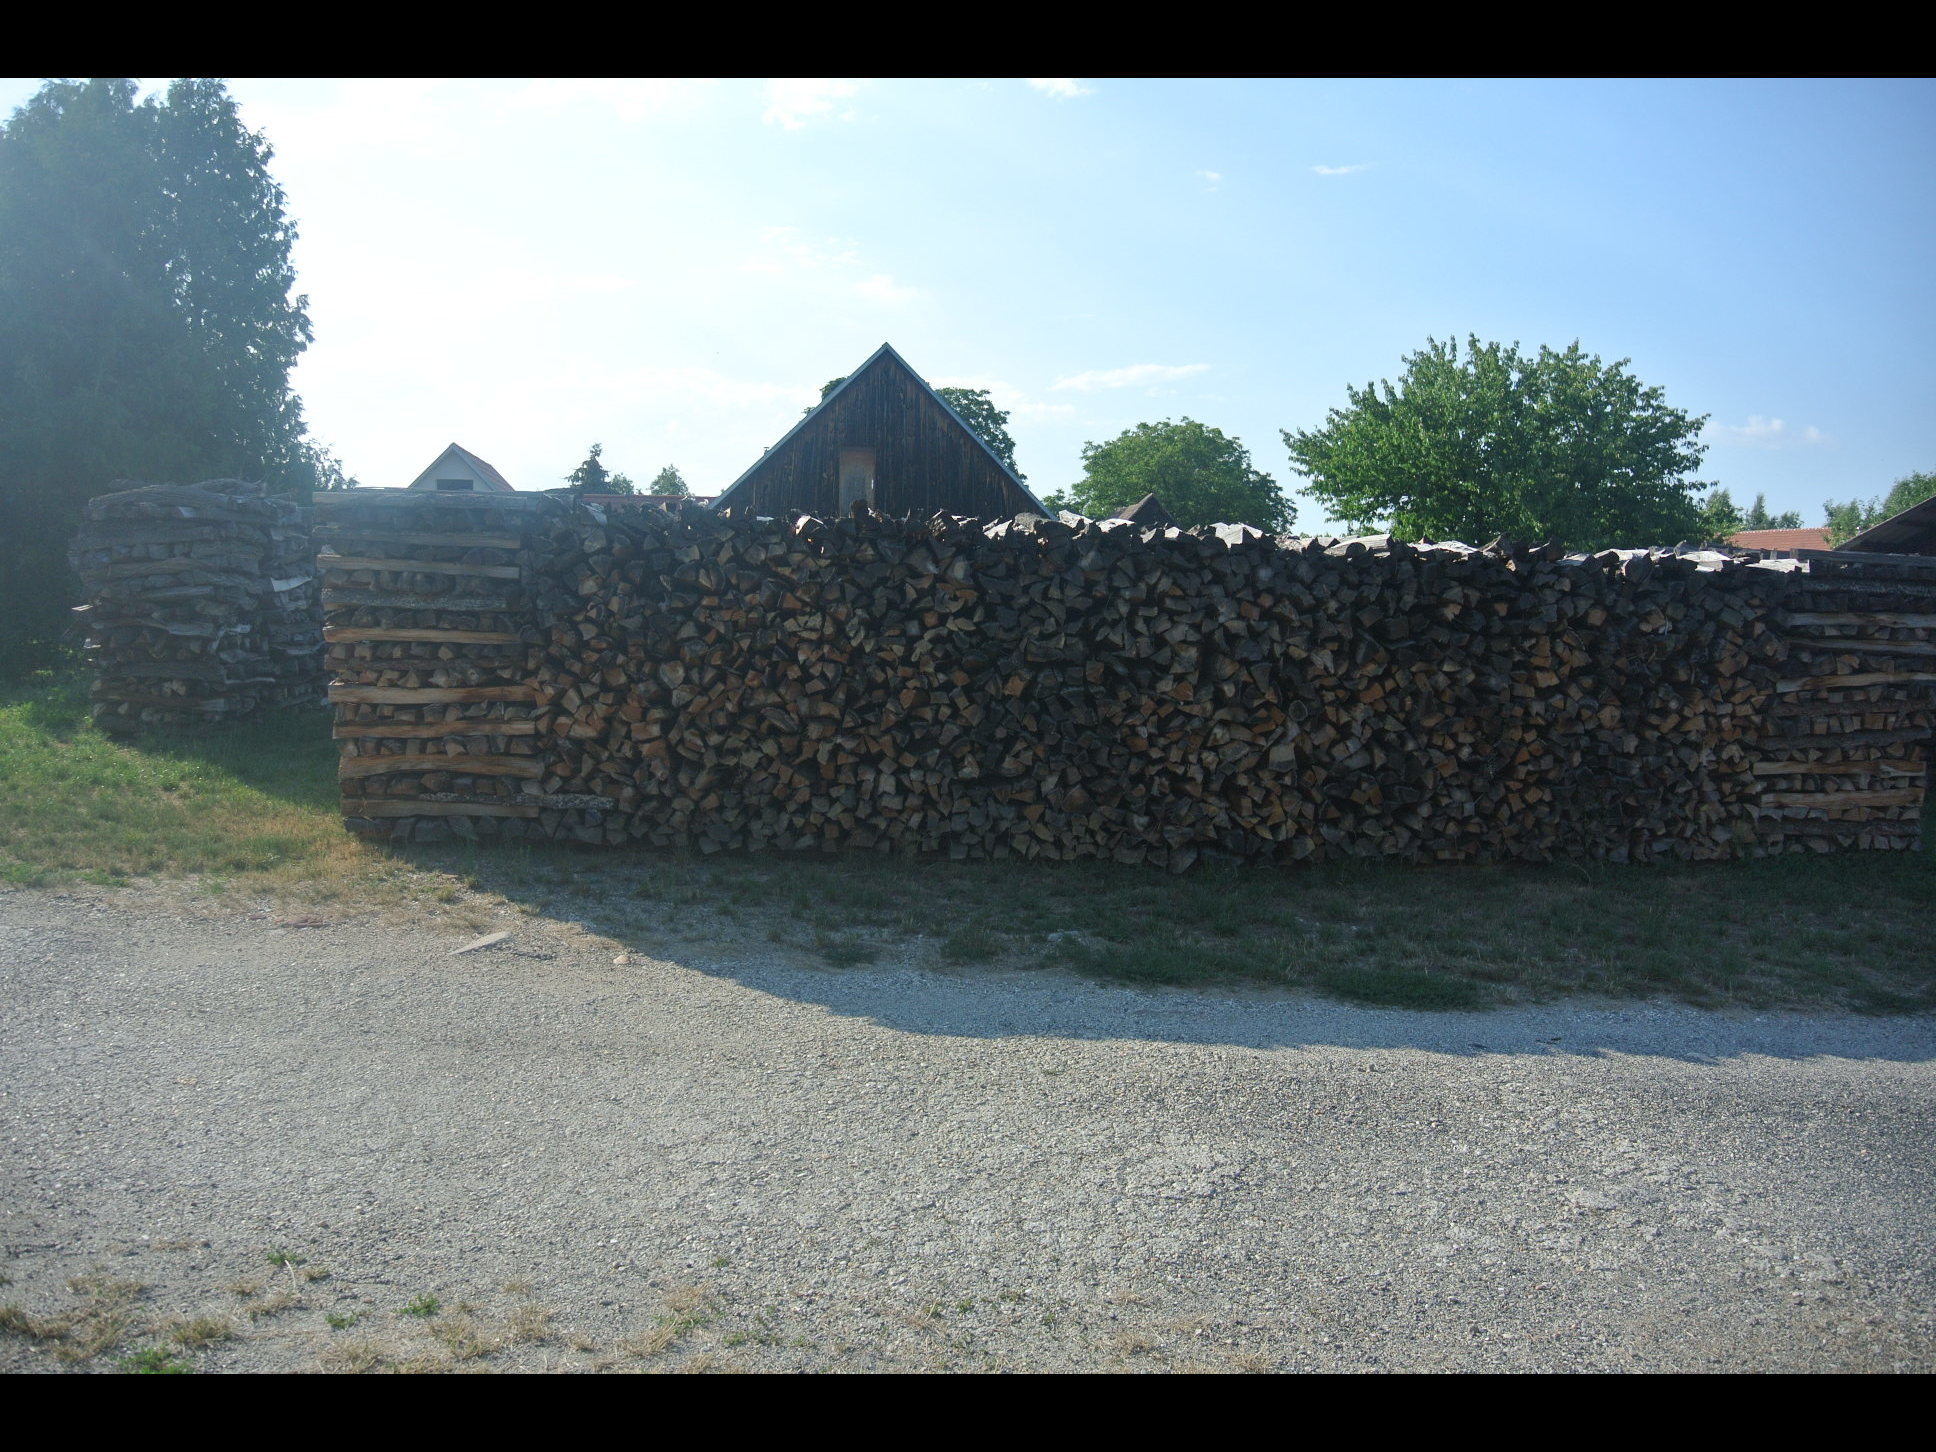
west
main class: Grassland
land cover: Grassland without tree/shrub cover
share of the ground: > 75 %
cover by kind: herbaceous plants 100 %
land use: Residential
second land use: Agriculture (excluding fallow land and kitchen gardens)
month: July
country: AT
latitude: 47.4725
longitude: 16.4919
